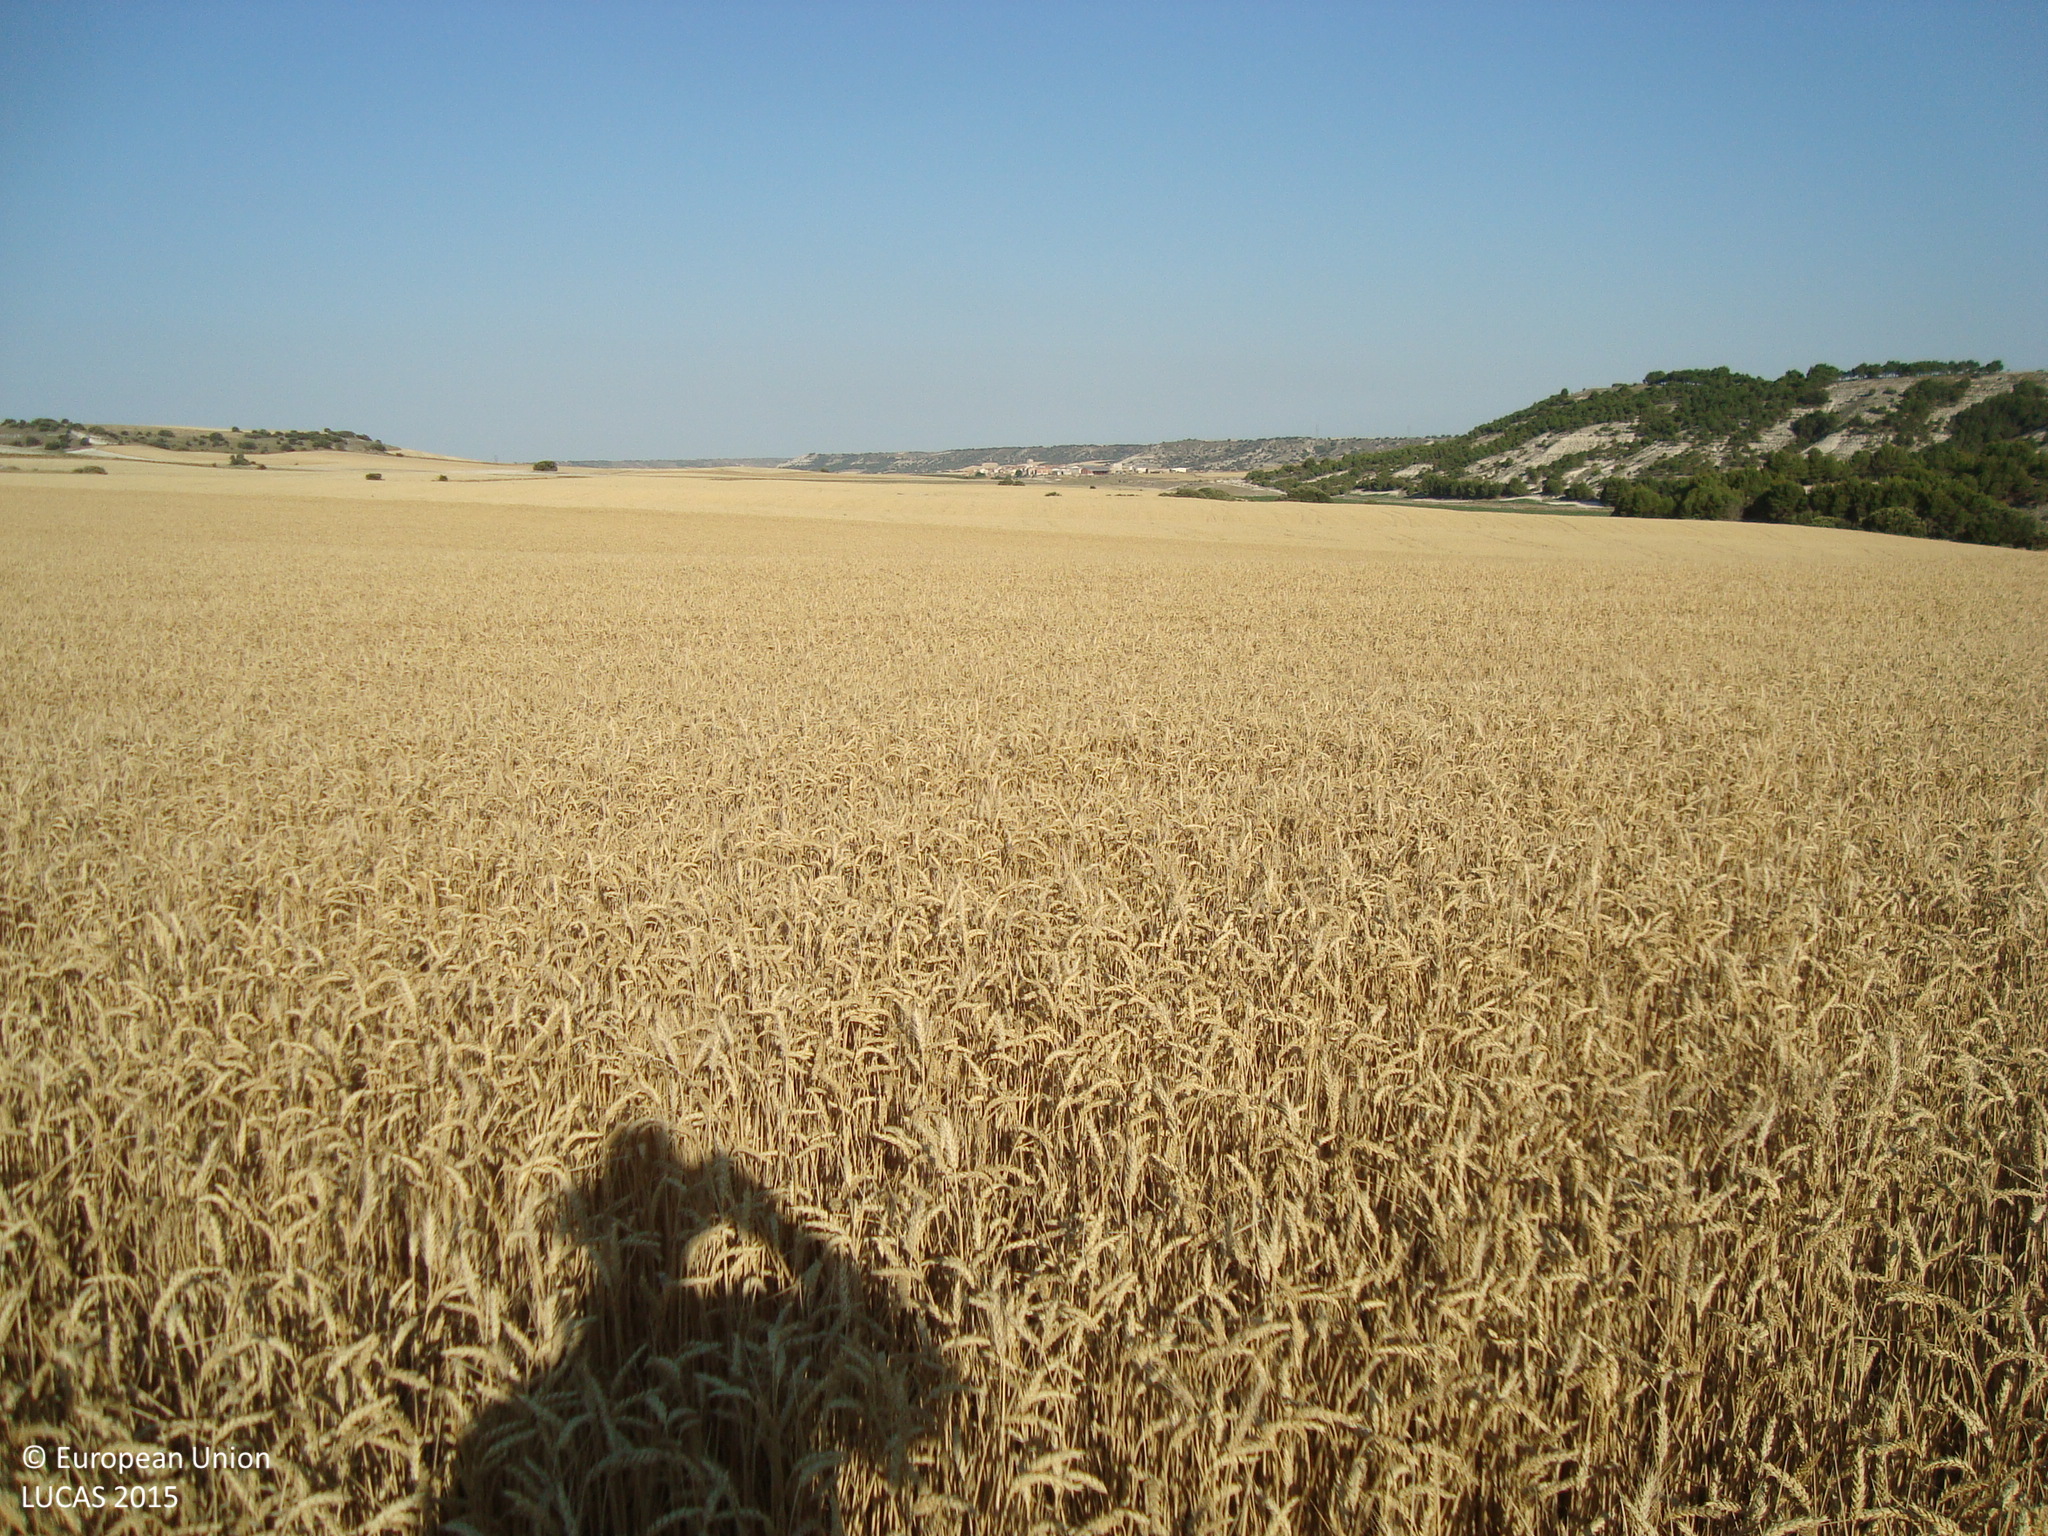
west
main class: Cropland
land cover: Common wheat
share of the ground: > 75 %
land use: Agriculture (excluding fallow land and kitchen gardens)
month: July
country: ES
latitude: 41.8580
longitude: -4.2662
